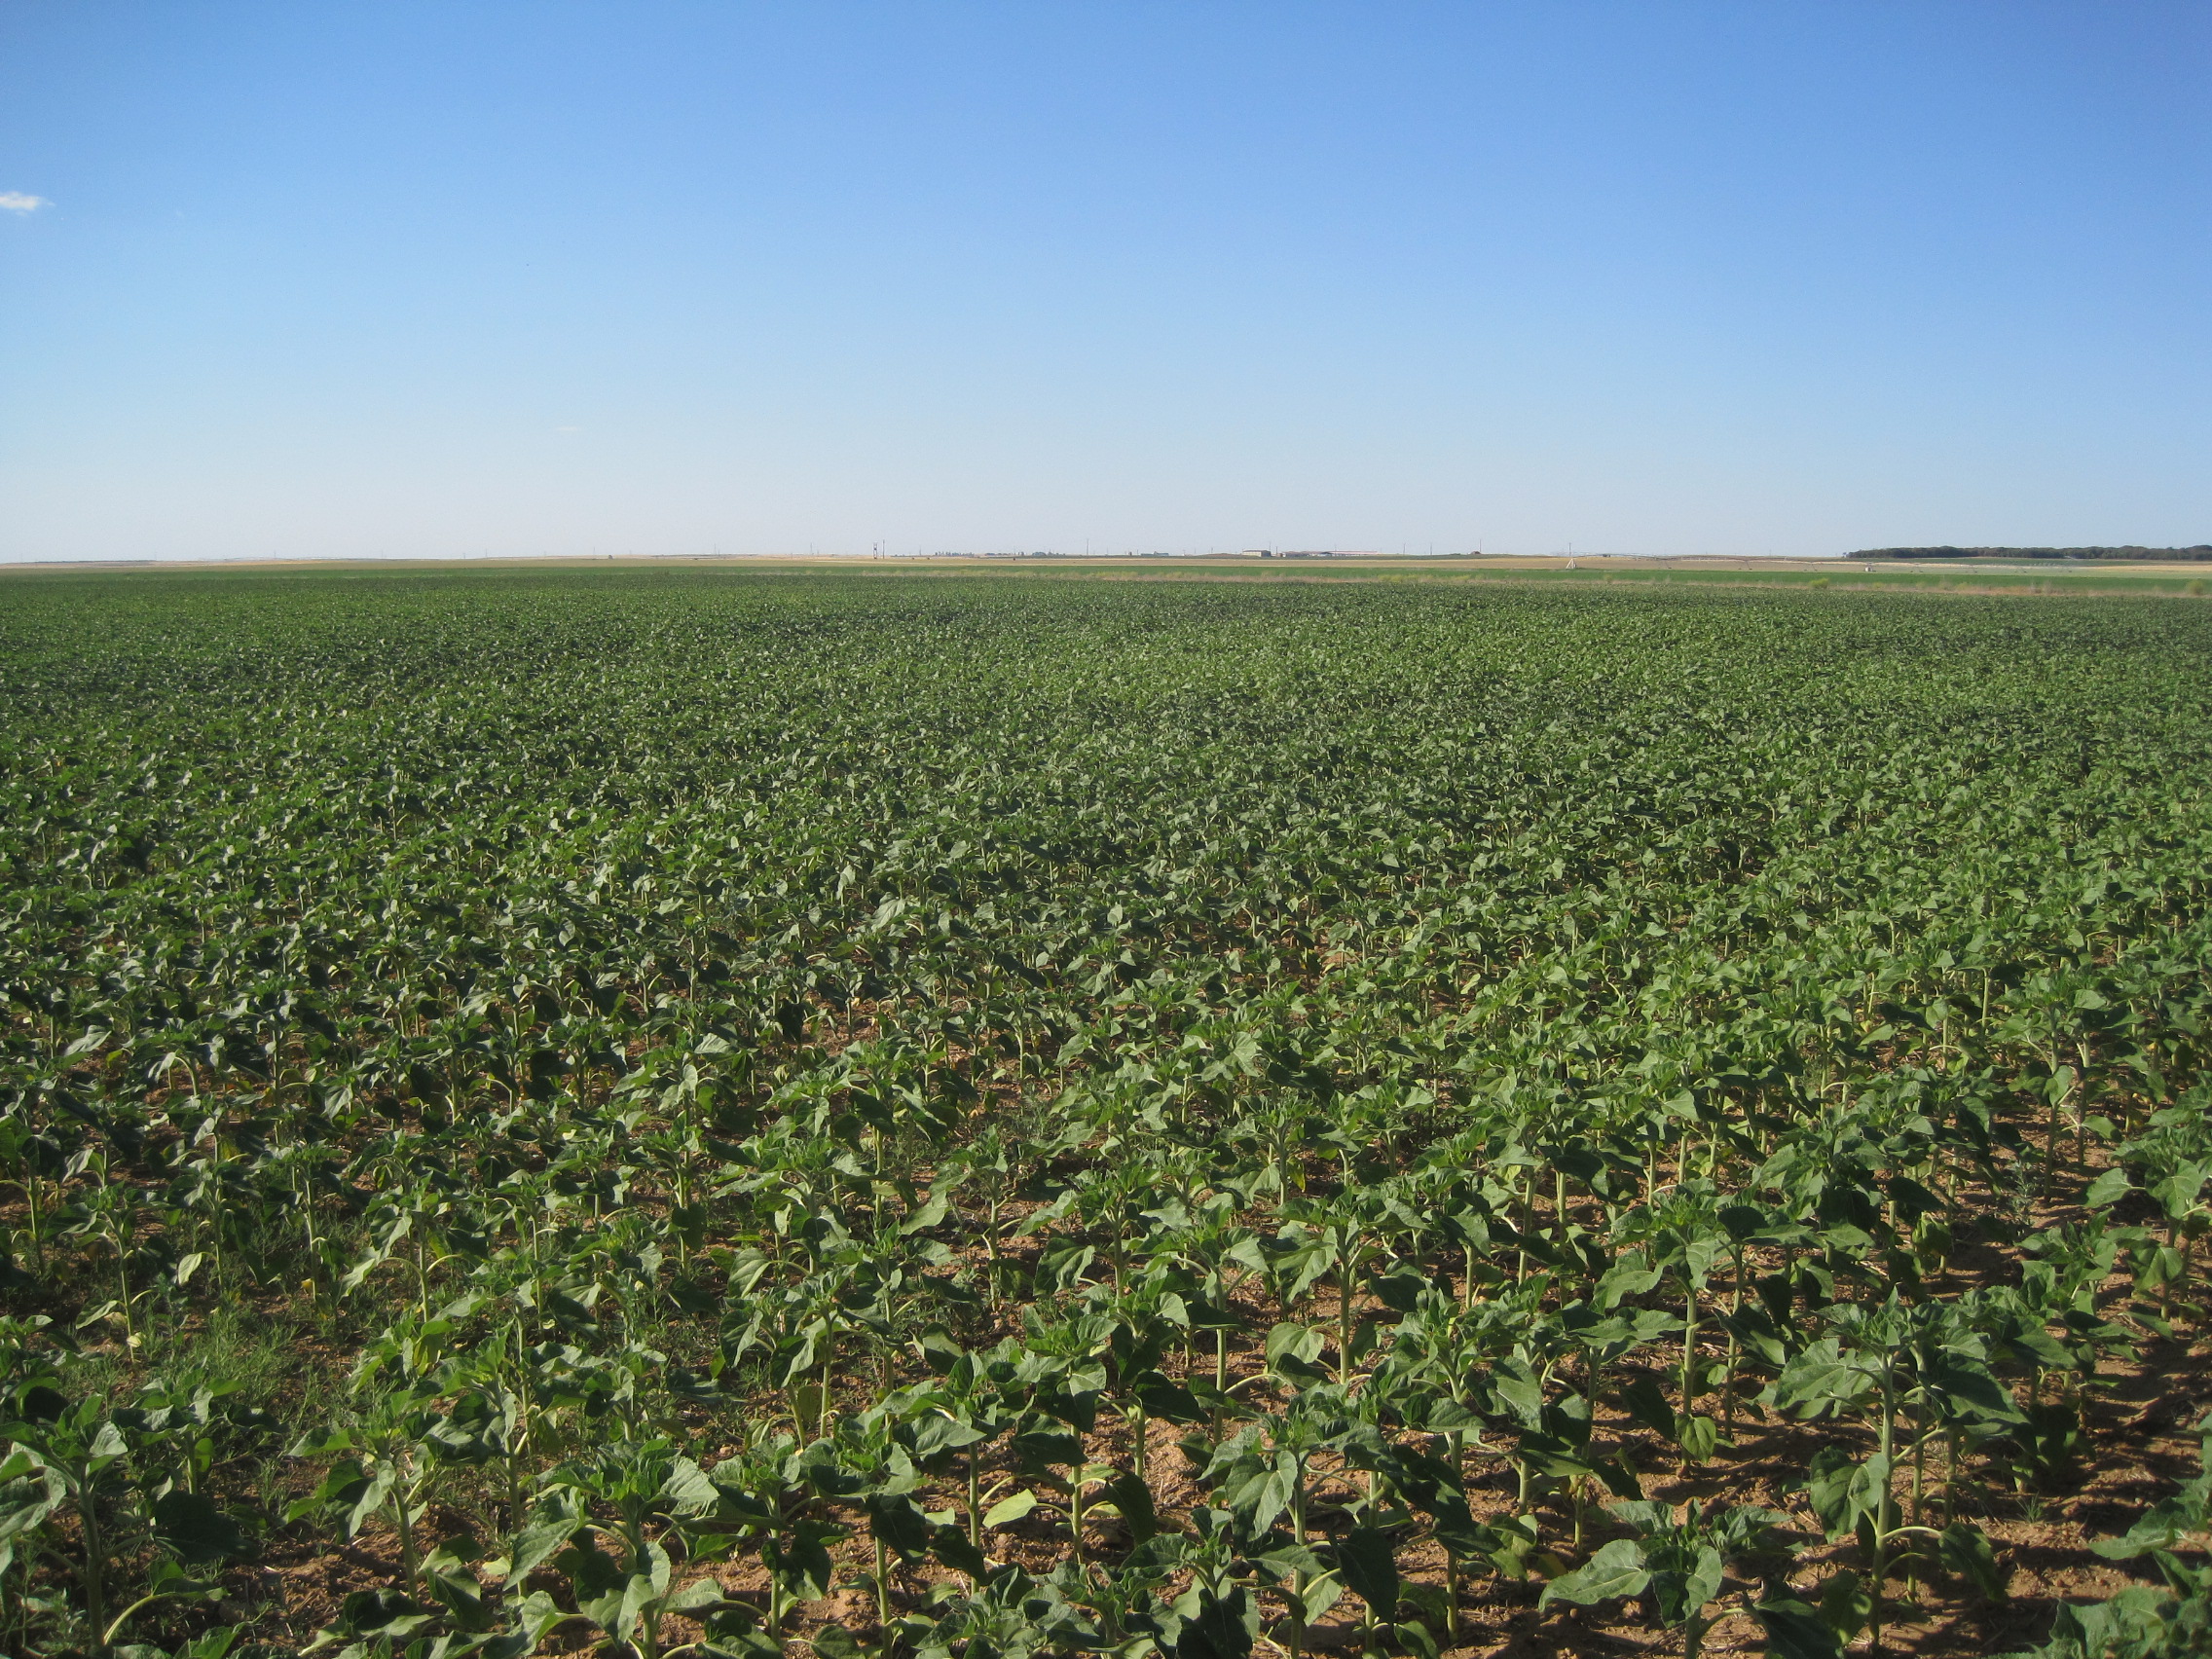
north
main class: Cropland
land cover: Sunflower
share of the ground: > 75 %
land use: Agriculture (excluding fallow land and kitchen gardens)
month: June
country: ES
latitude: 41.7917
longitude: -5.2059
